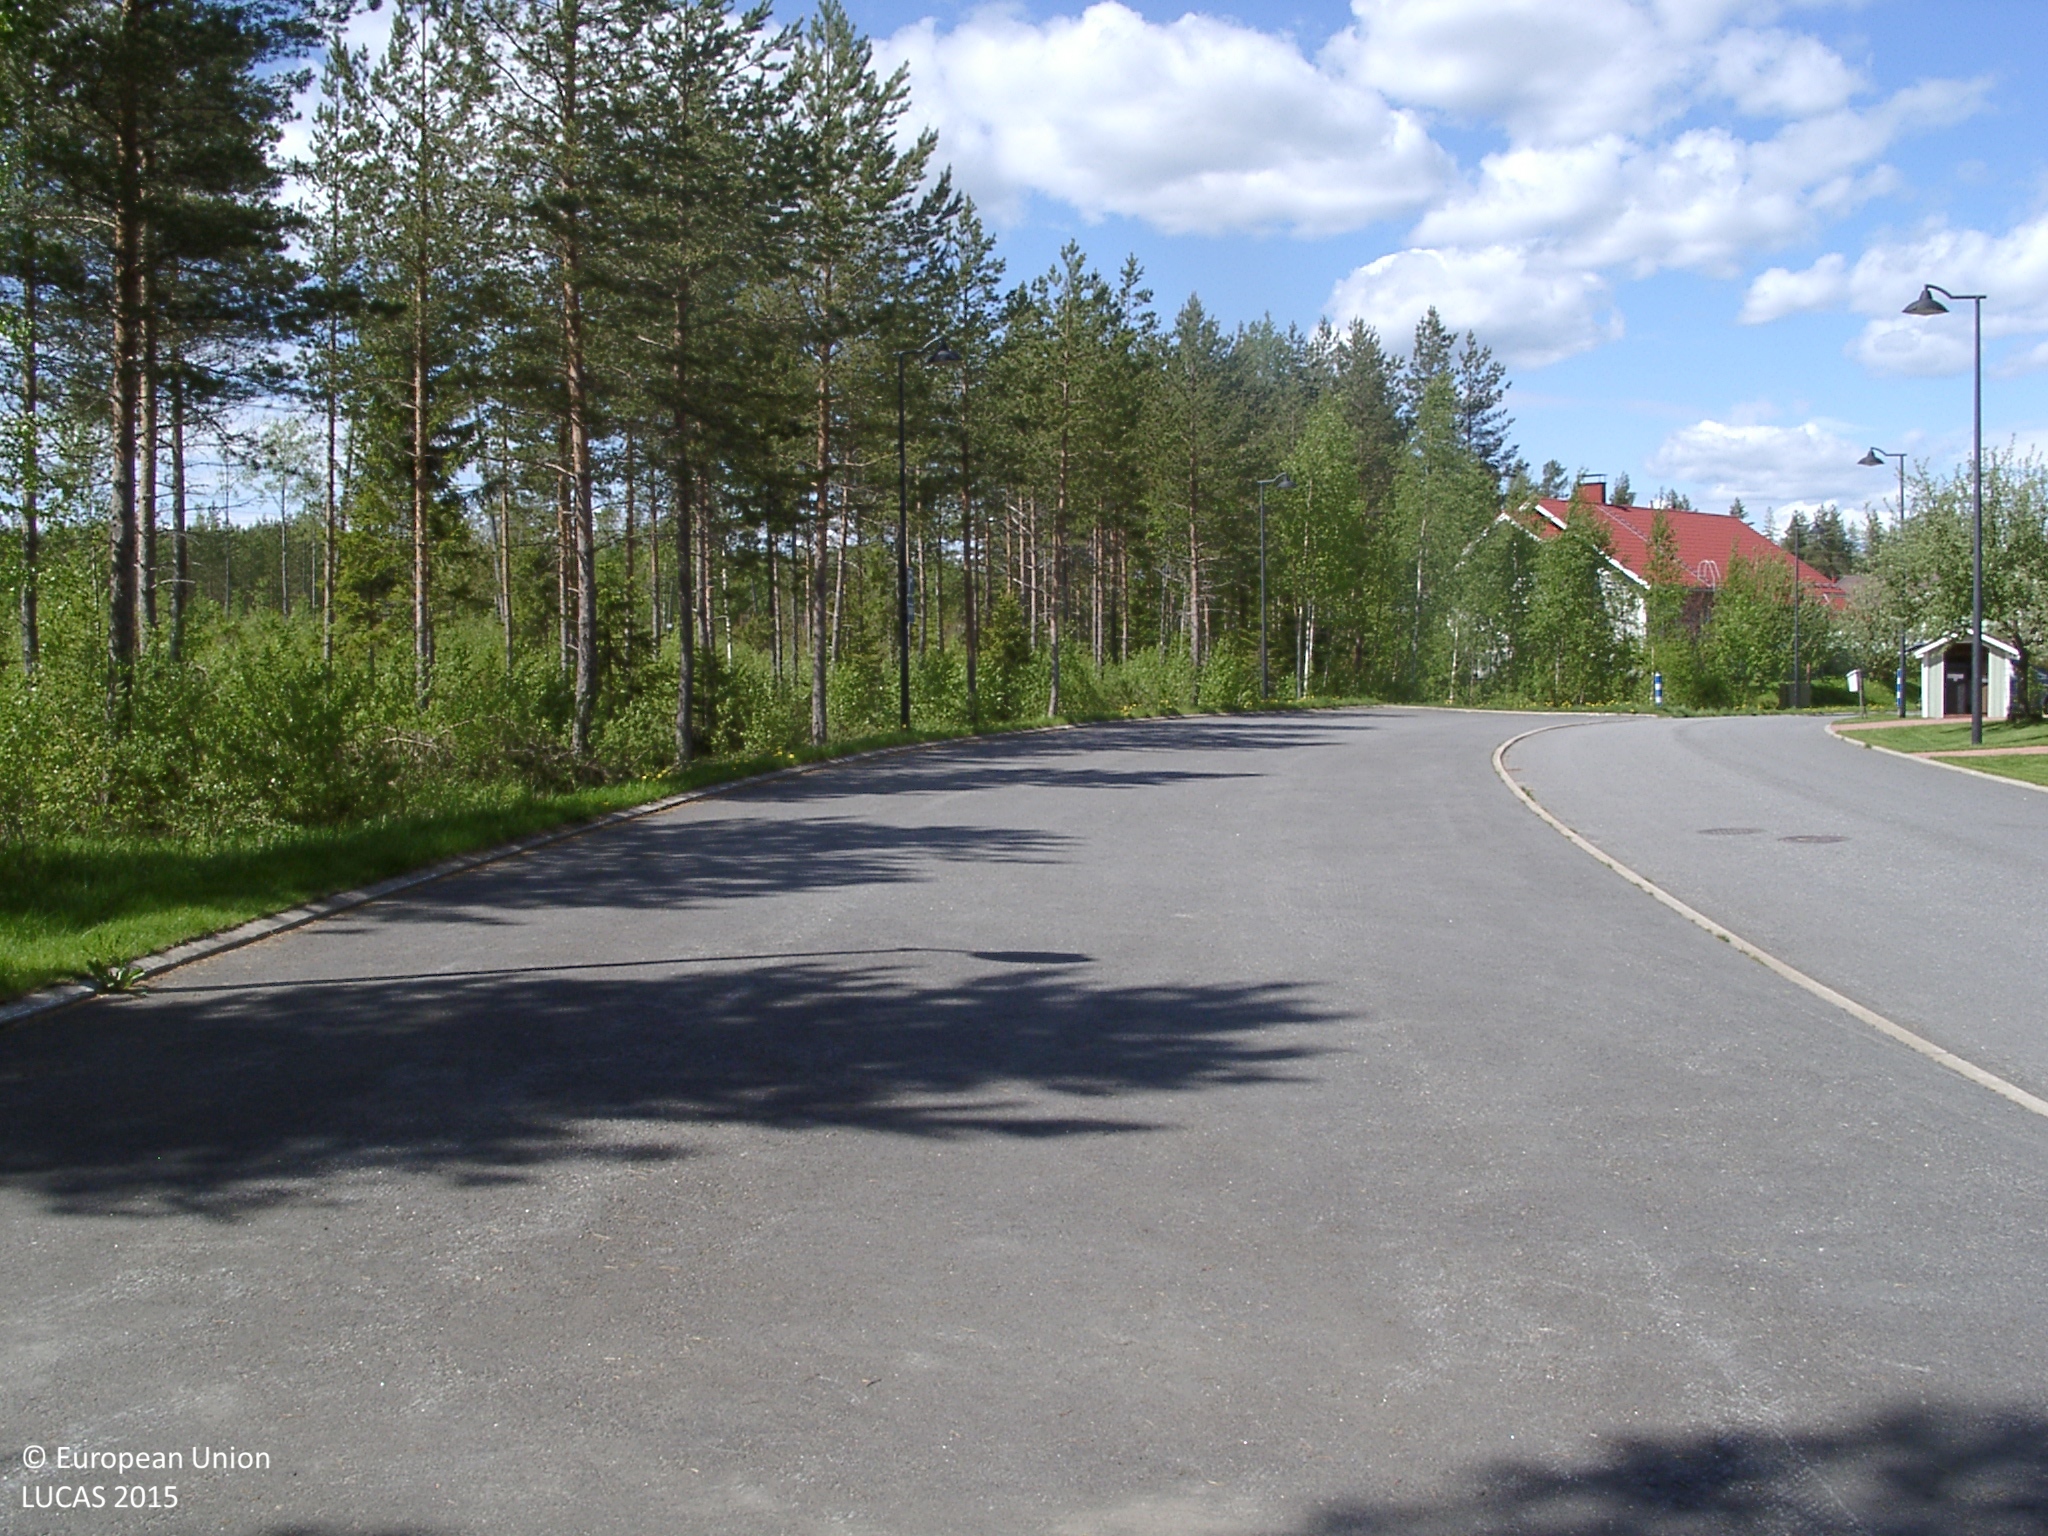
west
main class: Grassland
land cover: Grassland with sparse tree/shrub cover
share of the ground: > 75 %
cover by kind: herbaceous plants 90 %, broadleaved forest trees 5 %, shrubs 5 %
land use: Semi-natural and natural areas not in use
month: June
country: FI
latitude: 62.2298
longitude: 25.6436
